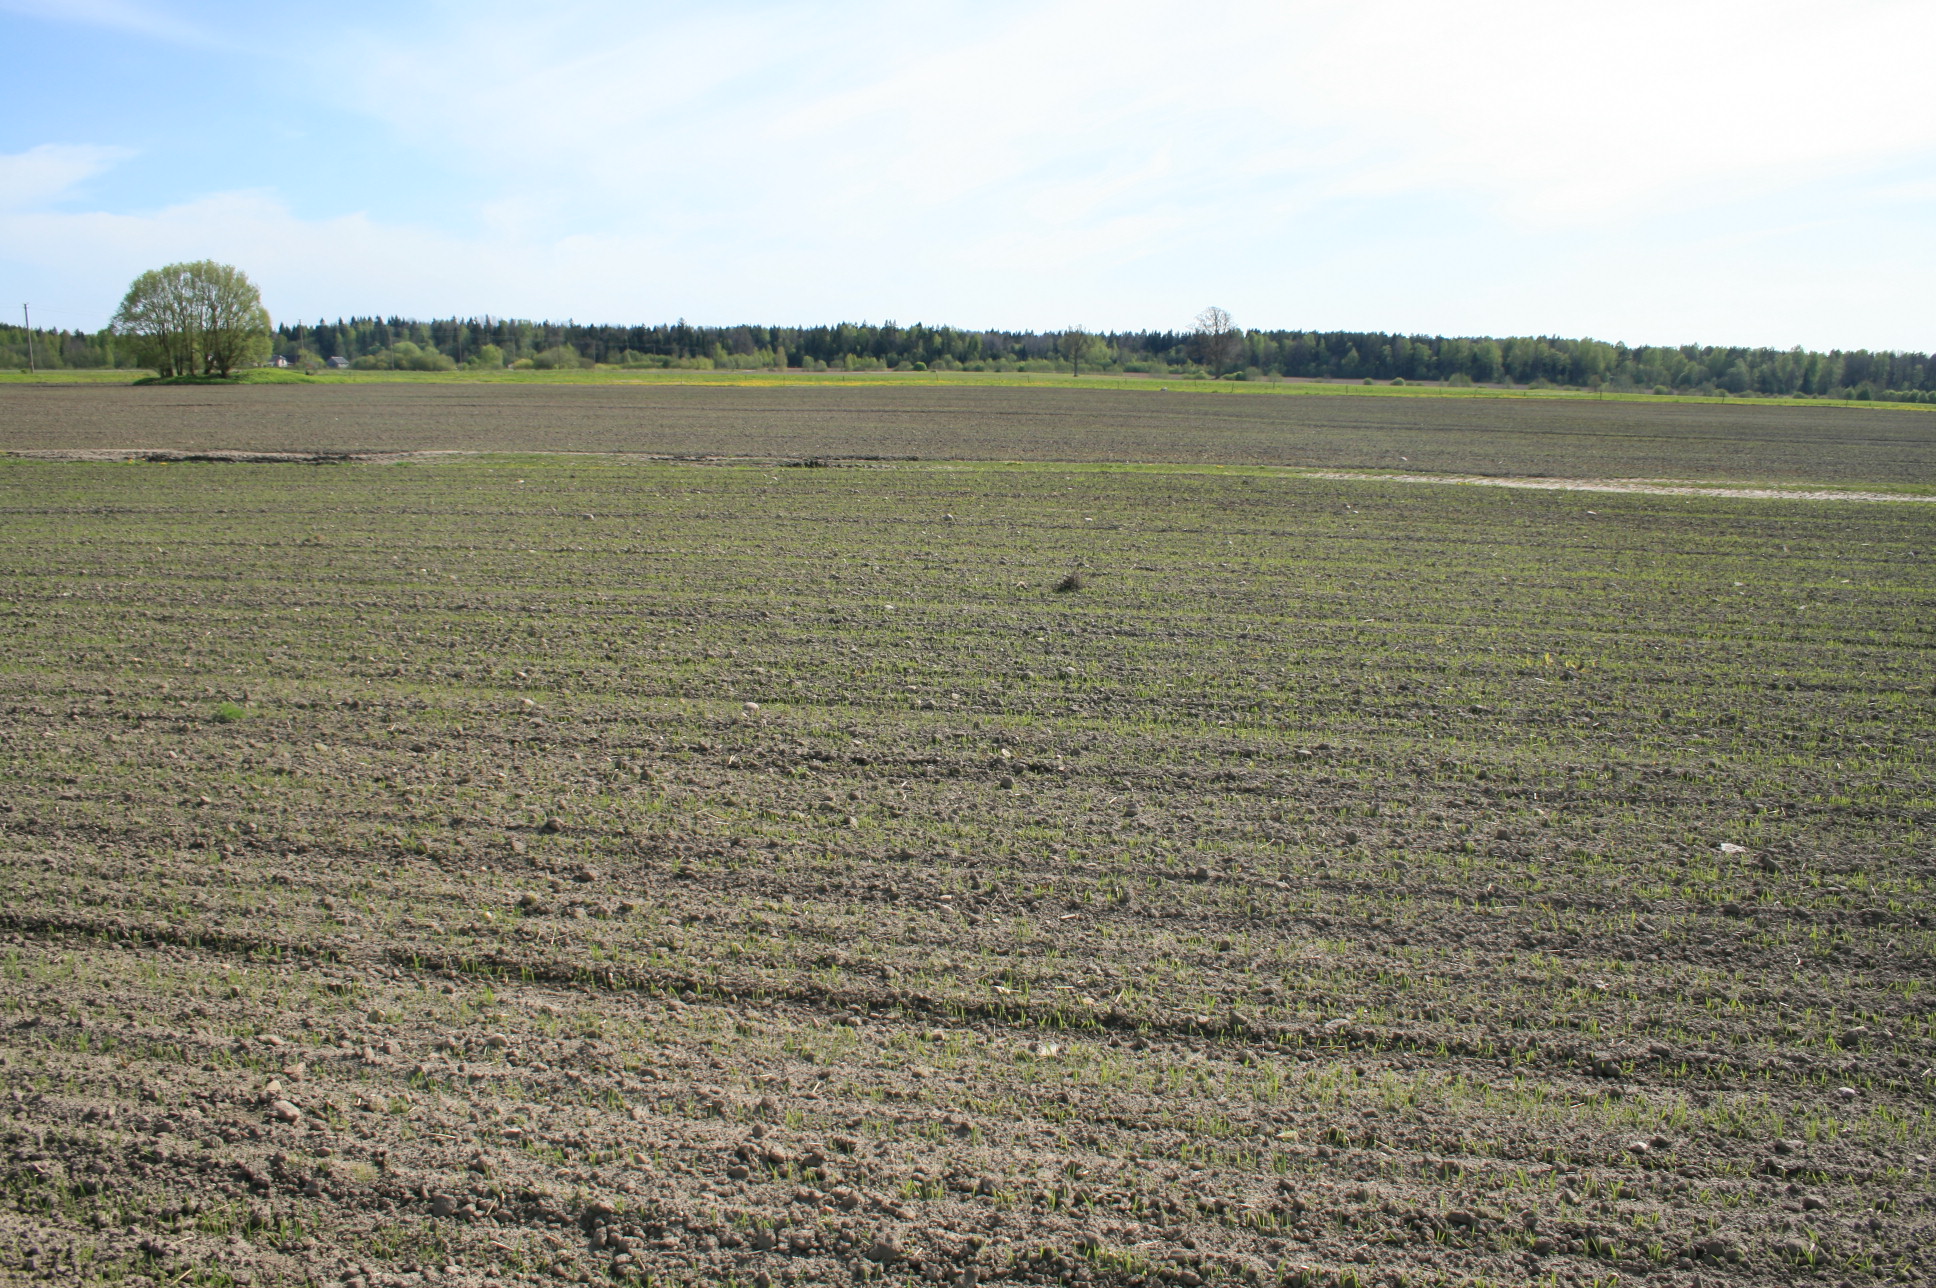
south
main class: Cropland
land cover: Barley
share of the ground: 10 - 25 %
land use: Agriculture (excluding fallow land and kitchen gardens)
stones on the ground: < 10 %
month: May
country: LT
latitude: 55.9742
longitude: 21.3390
